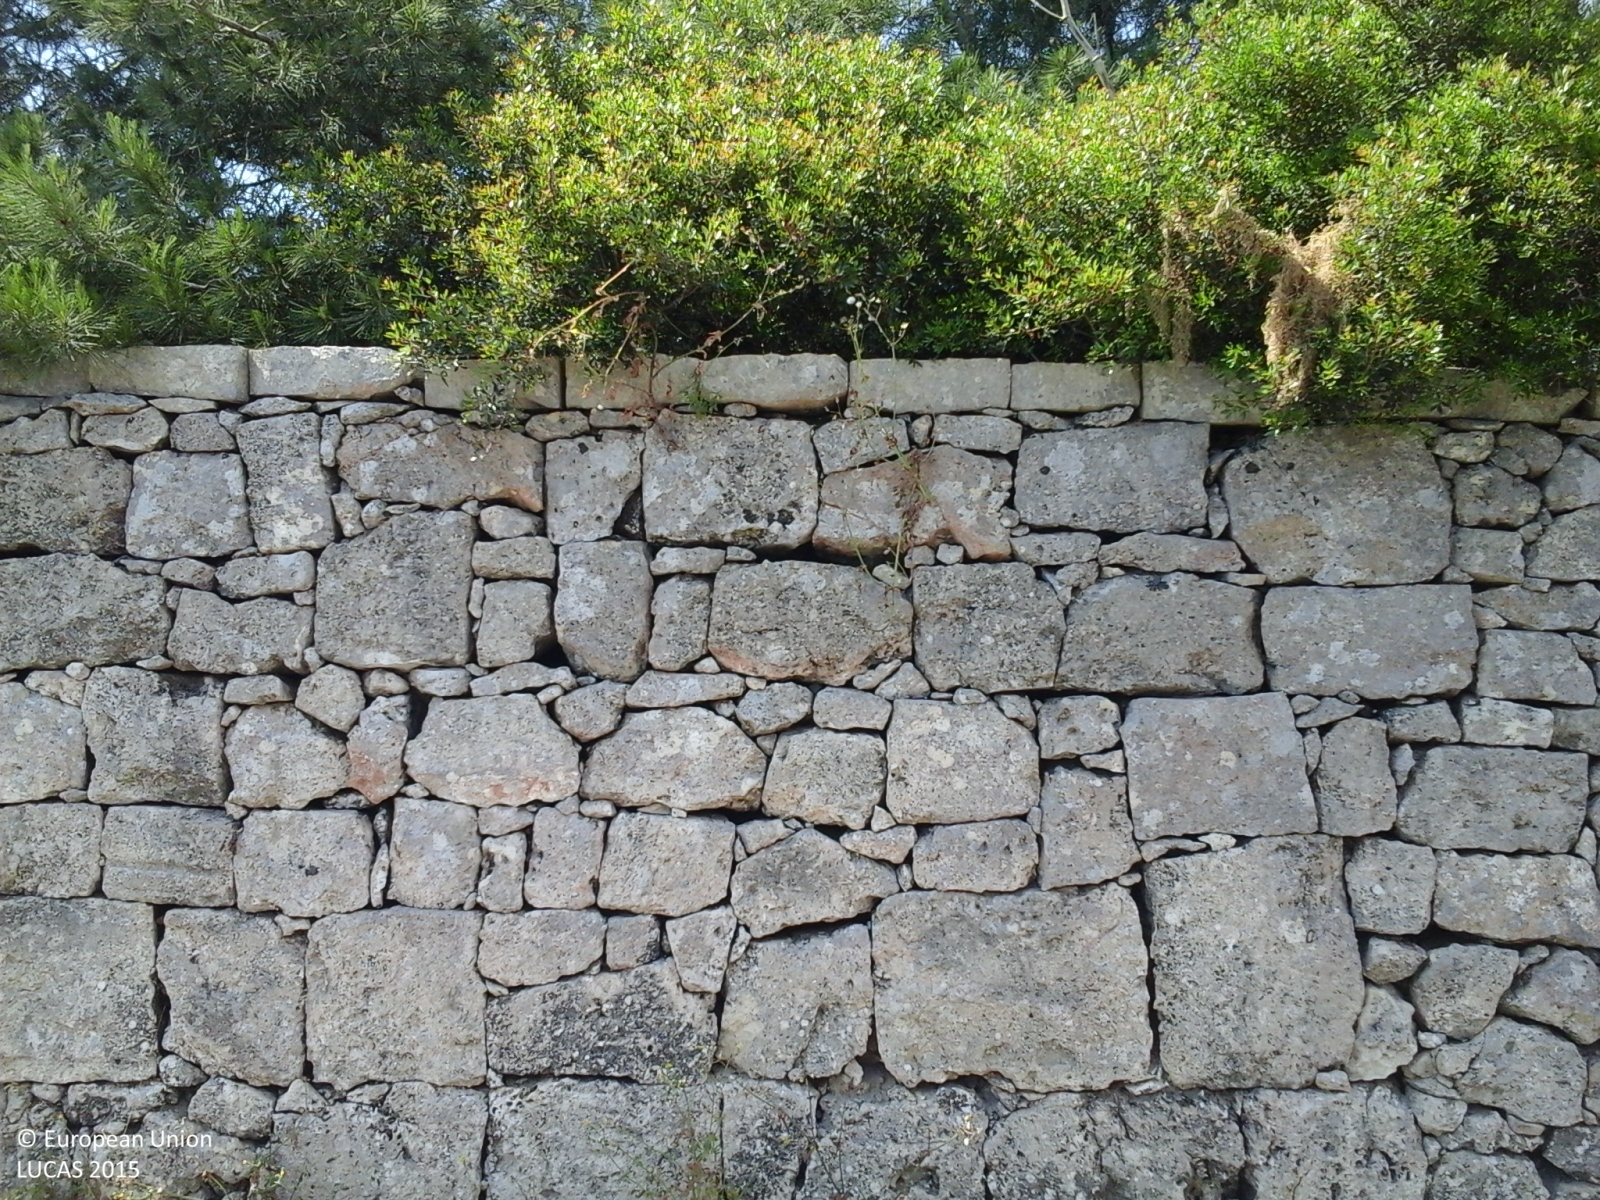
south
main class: Woodland
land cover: Pine dominated coniferous woodland
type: coniferous forest of the mediterranean region
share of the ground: > 75 %
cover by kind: coniferous forest trees 80 %, herbaceous plants 20 %
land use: Residential
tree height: > 5 m
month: May
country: MT
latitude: 35.8623
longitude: 14.3999
